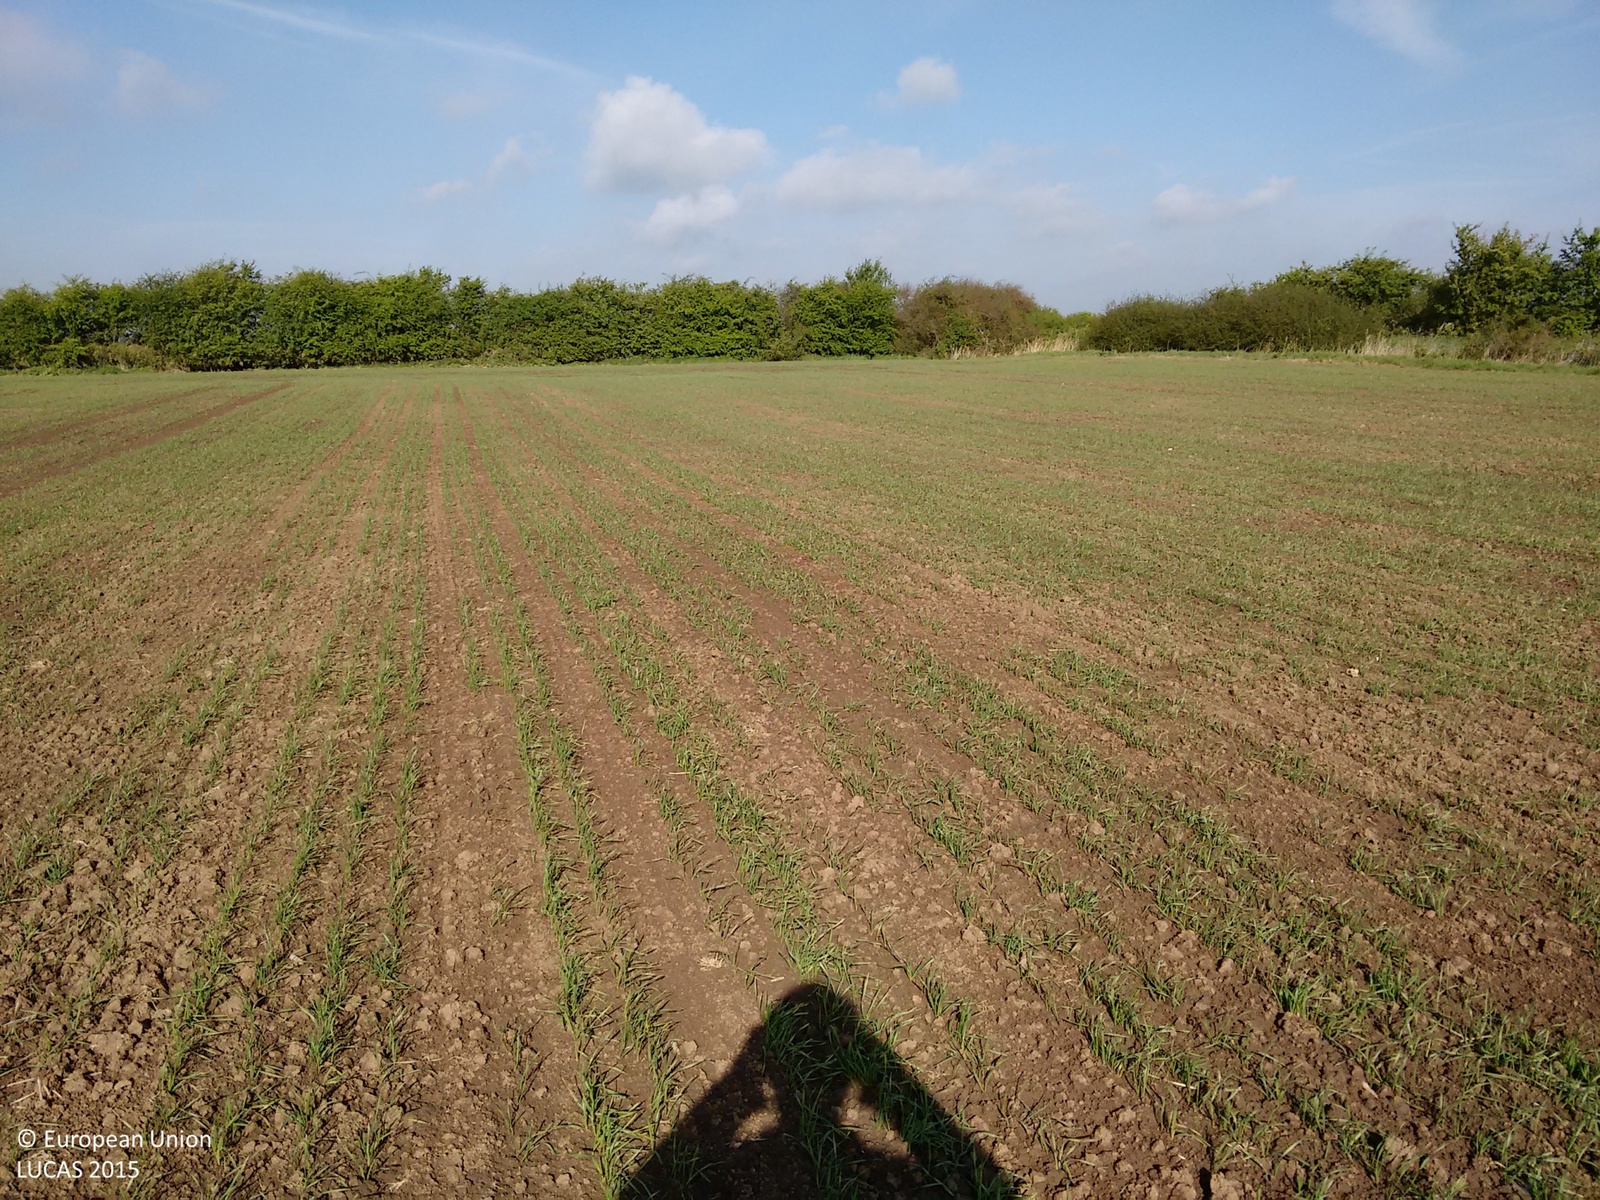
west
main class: Cropland
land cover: Common wheat
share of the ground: < 10 %
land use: Agriculture (excluding fallow land and kitchen gardens)
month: May
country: GB
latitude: 53.2807
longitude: 0.2670
